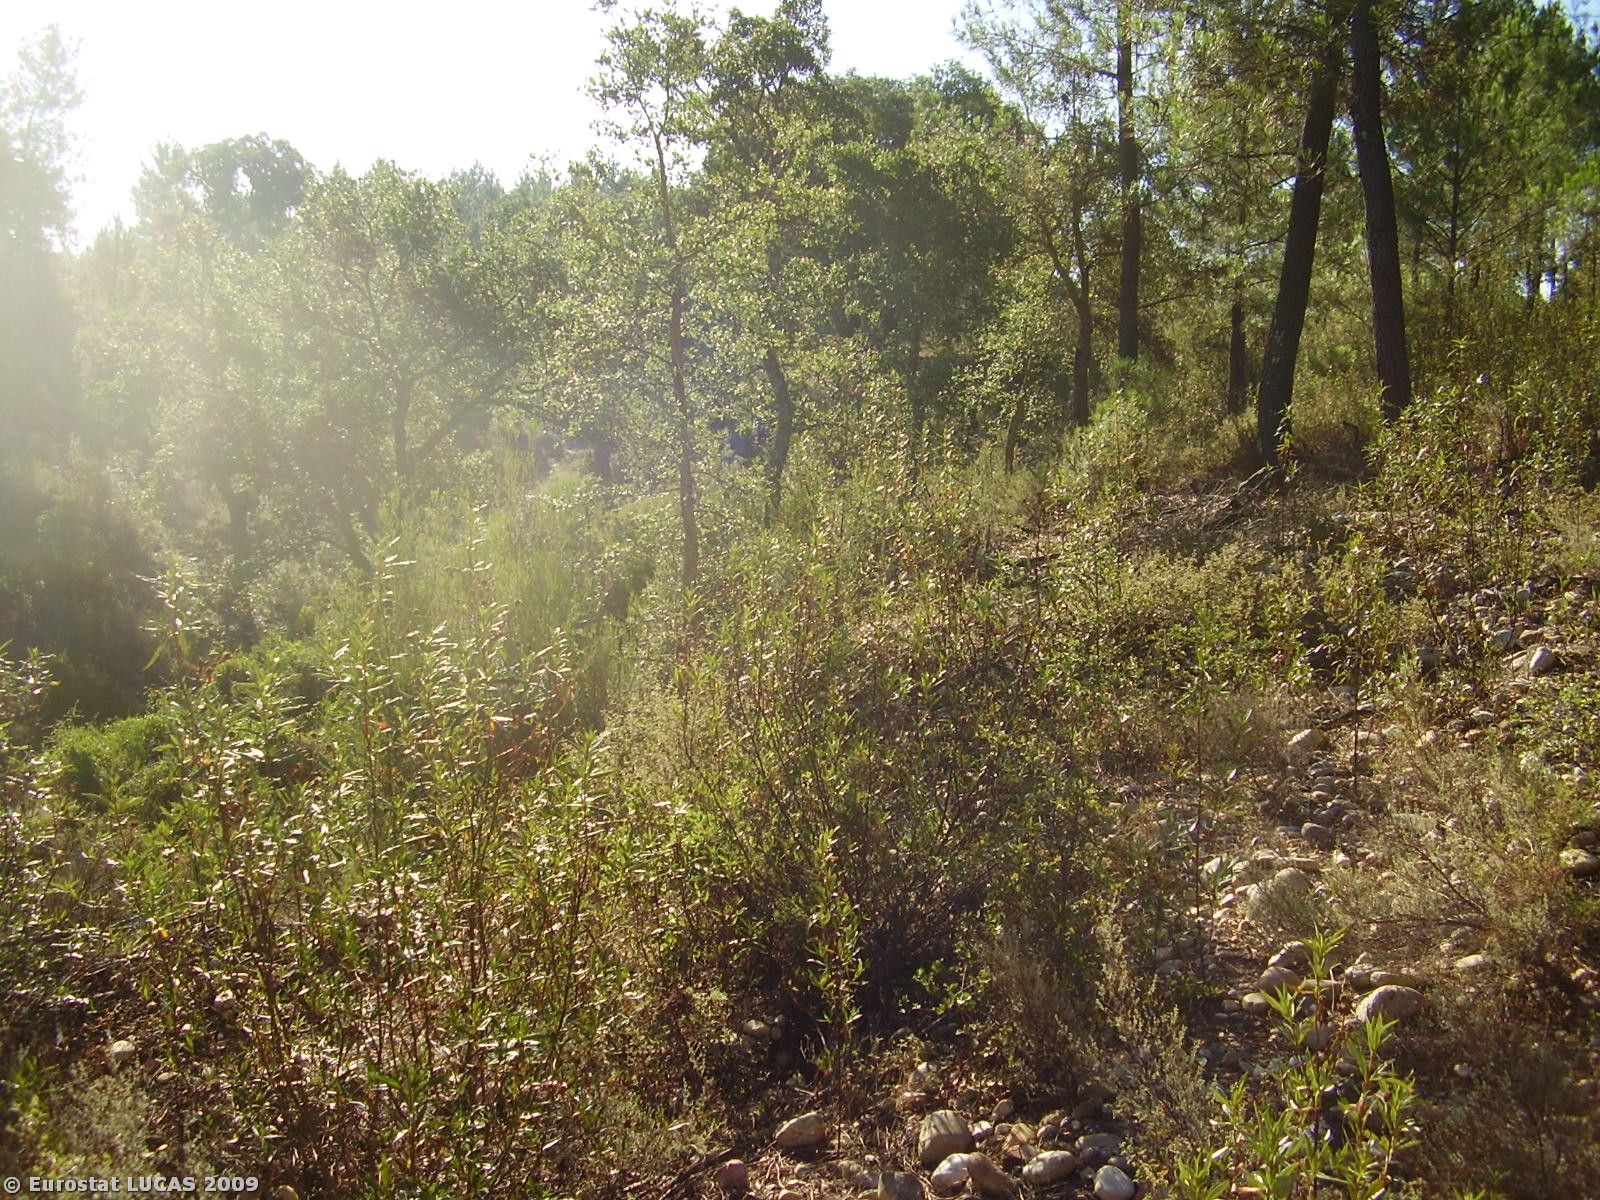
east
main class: Woodland
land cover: Mixed woodland
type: broadleaved evergreen forest
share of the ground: < 10 %
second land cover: Shrubland with sparse tree cover
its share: 25 - 50 %
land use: Forestry
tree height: > 5 m
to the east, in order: Mixed woodland; Shrubland with sparse tree cover; Mixed woodland; Rivers and streams; Mixed woodland; Rivers and streams; Mixed woodland; Bare land
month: July
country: PT
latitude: 39.3791
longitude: -8.1117
